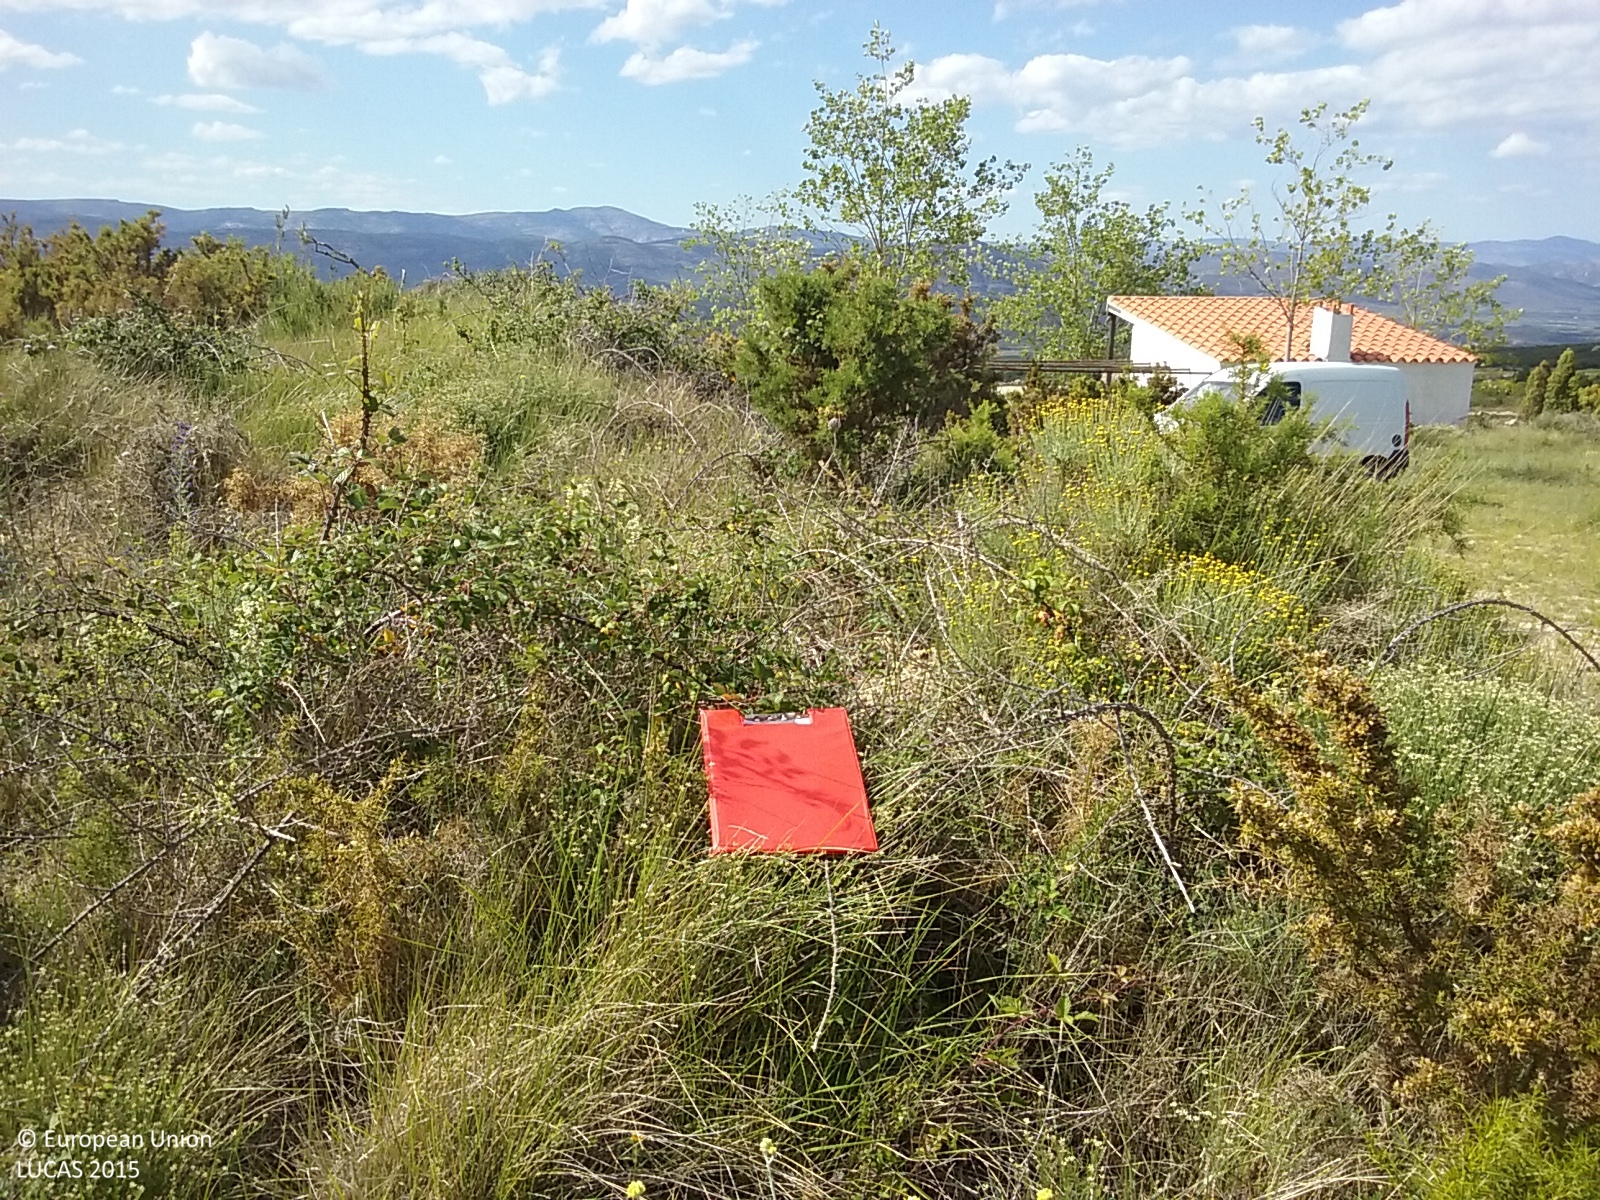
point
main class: Shrubland
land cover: Shrubland with sparse tree cover
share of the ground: > 75 %
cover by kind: shrubs 70 %, herbaceous plants 20 %, coniferous forest trees 5 %
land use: Semi-natural and natural areas not in use
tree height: < 5 m
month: May
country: ES
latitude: 40.3430
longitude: 0.0483
